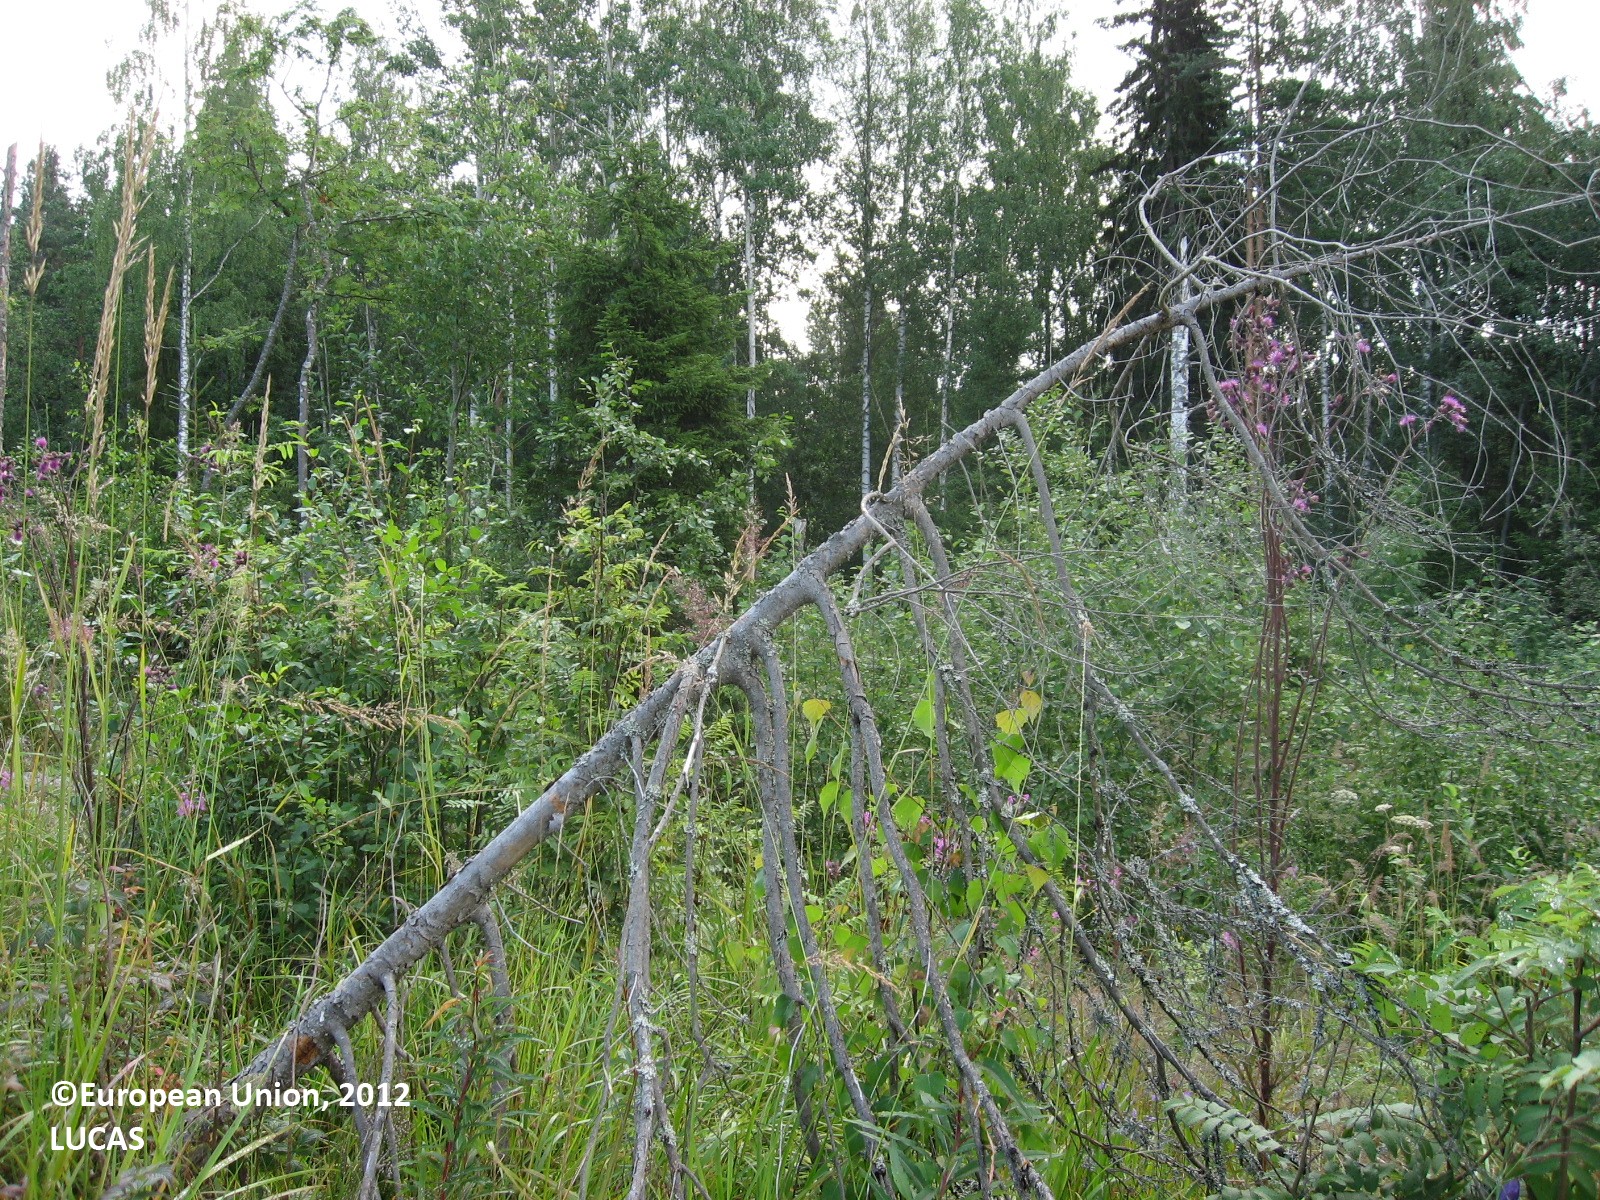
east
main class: Woodland
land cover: Broadleaved woodland
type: boreal forest
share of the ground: 25 - 50 %
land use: Forestry
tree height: < 5 m
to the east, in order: Broadleaved woodland; Spontaneously vegetated surfaces; Broadleaved woodland; Spruce dominated mixed woodland; Spontaneously vegetated surfaces; Spruce dominated mixed woodland; Ditches and canals; Spruce dominated mixed woodland
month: July
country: FI
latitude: 61.3185
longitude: 25.8778
